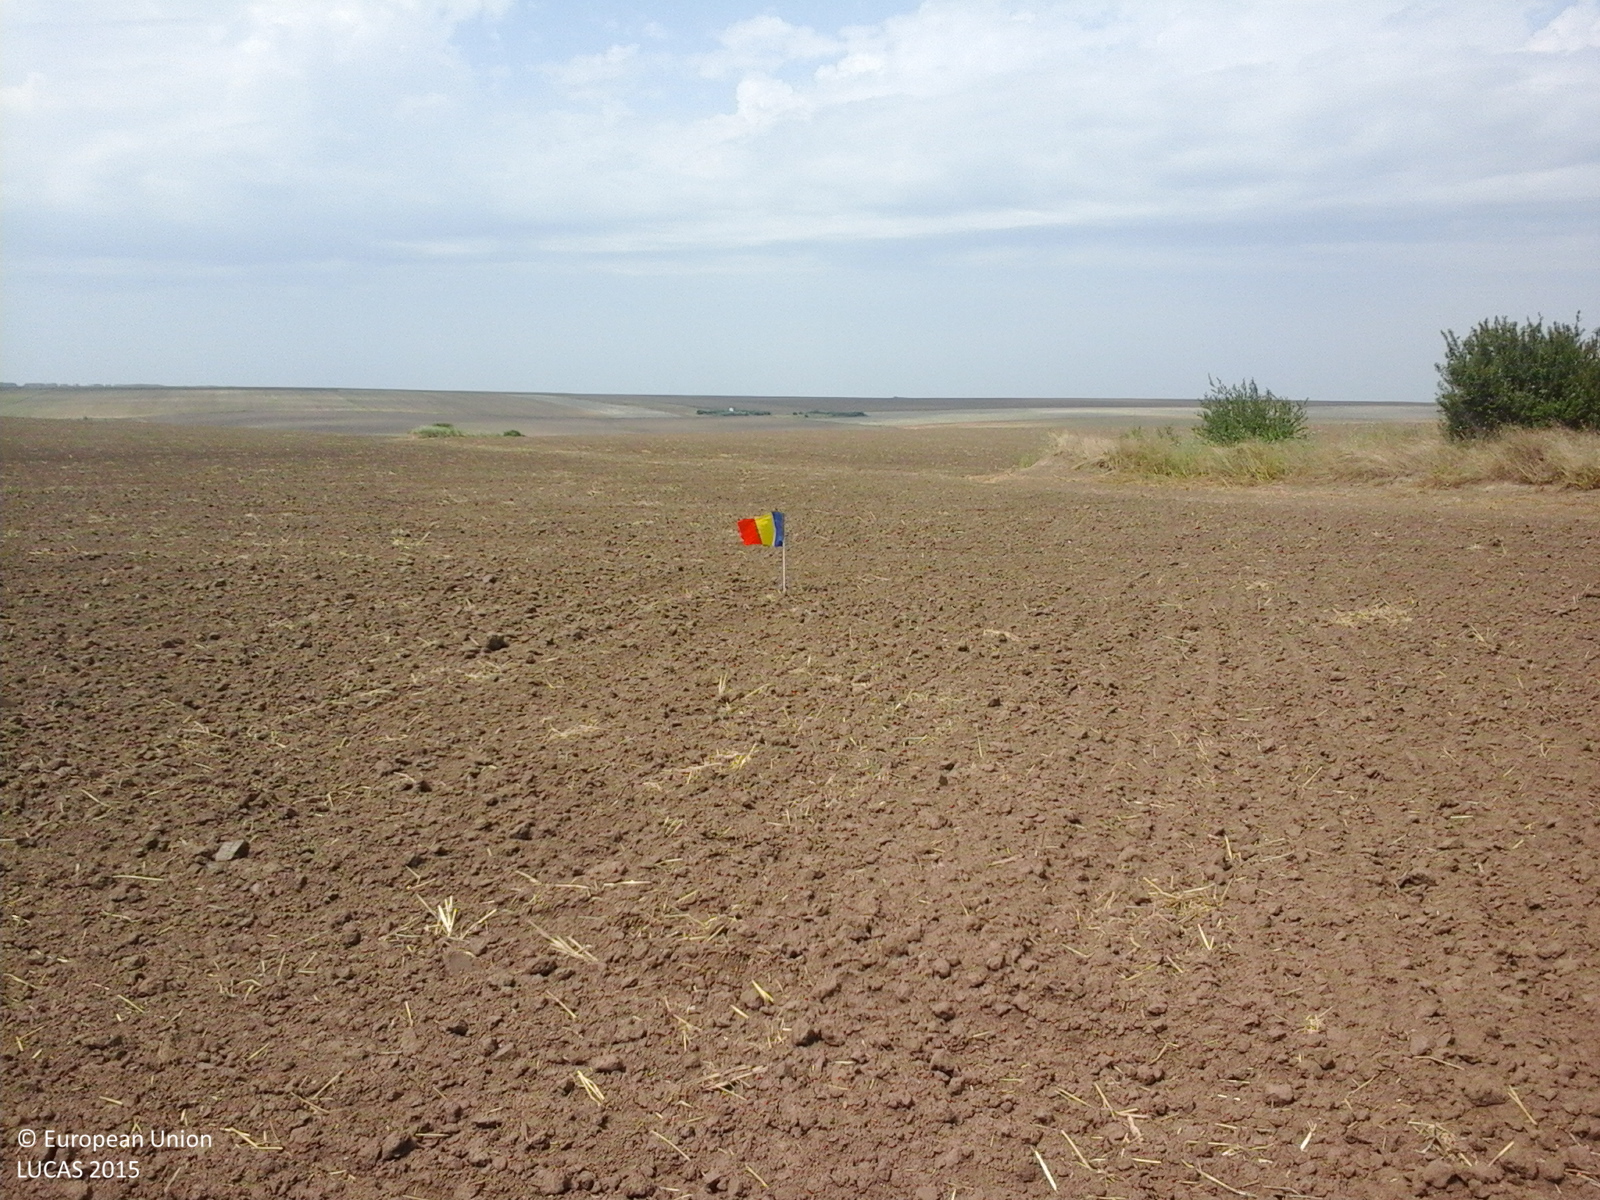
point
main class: Cropland
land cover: Common wheat
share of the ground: < 10 %
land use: Agriculture (excluding fallow land and kitchen gardens)
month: August
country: RO
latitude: 43.8575
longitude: 28.0546
